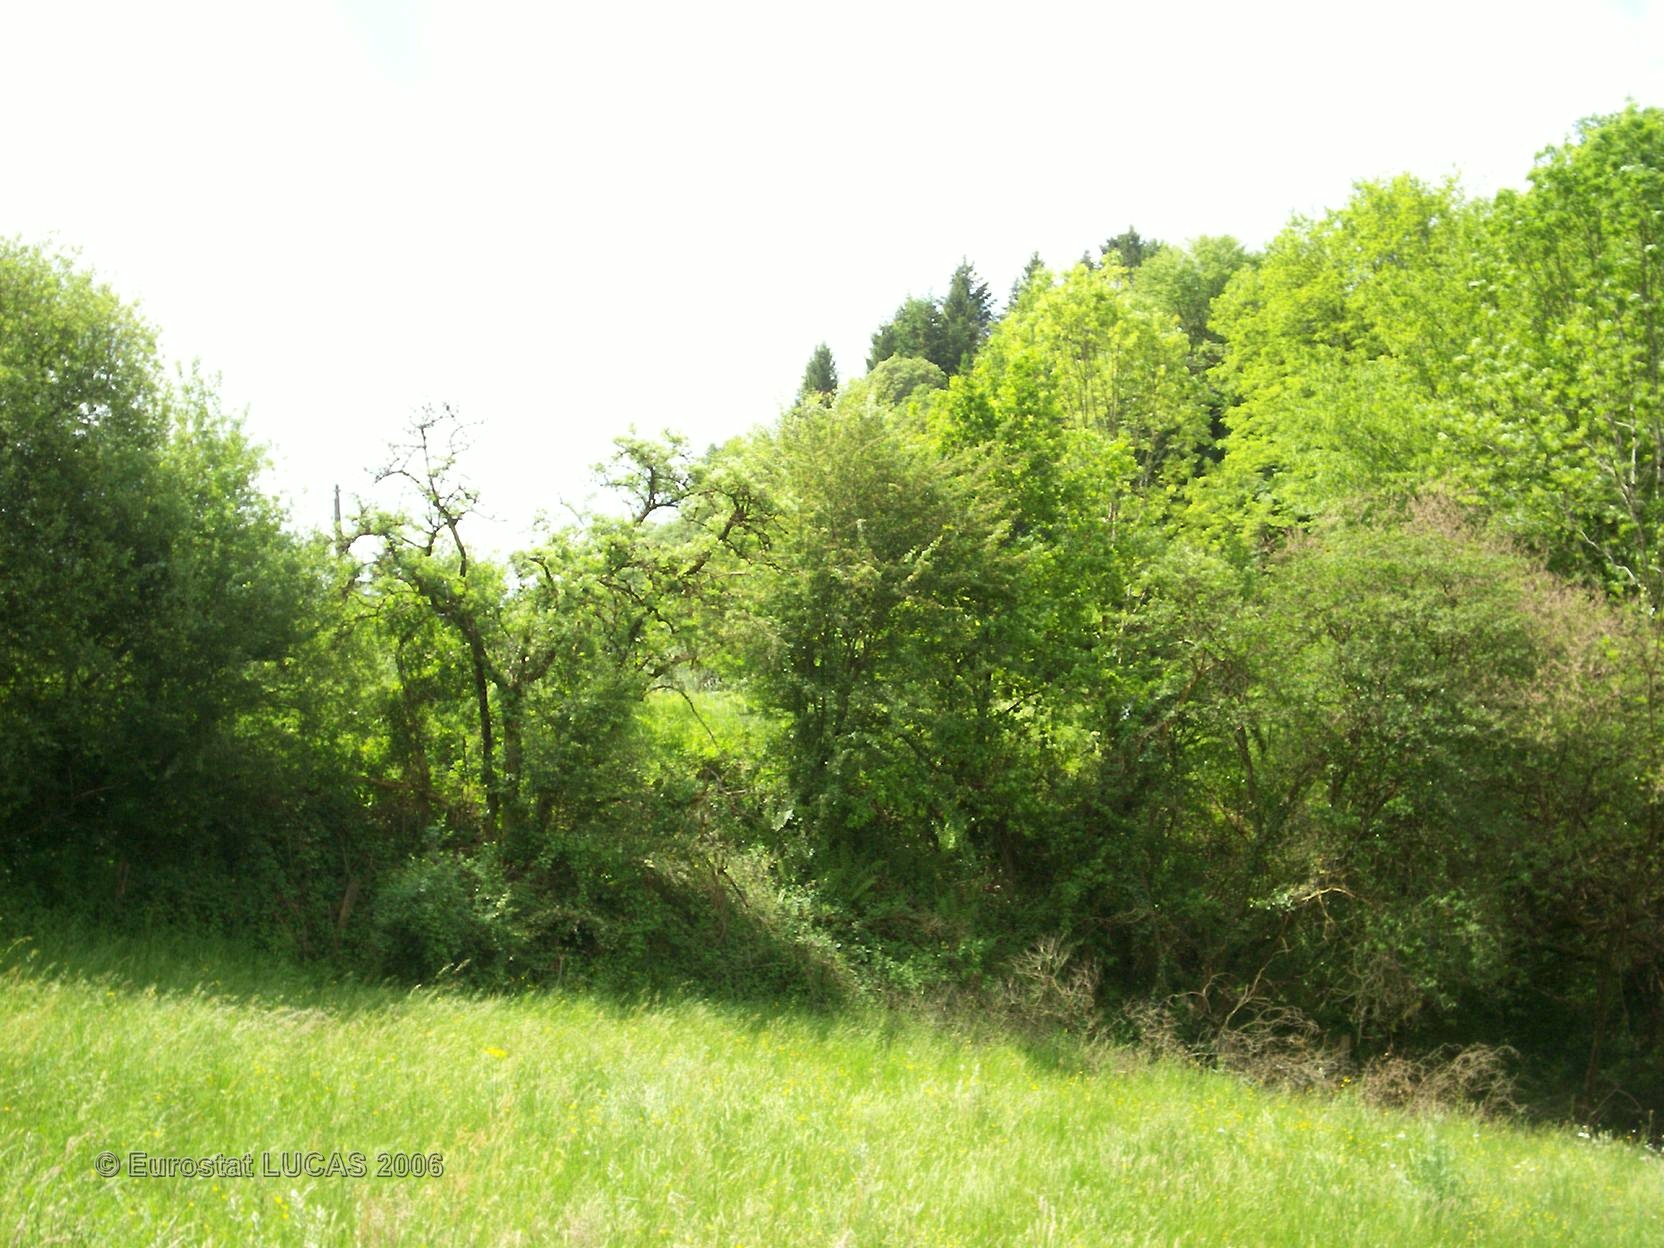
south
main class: Grassland
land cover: Grassland without tree/shrub cover
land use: Agriculture (excluding fallow land and kitchen gardens)
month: May
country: FR
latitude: 45.2577
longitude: 1.8025
